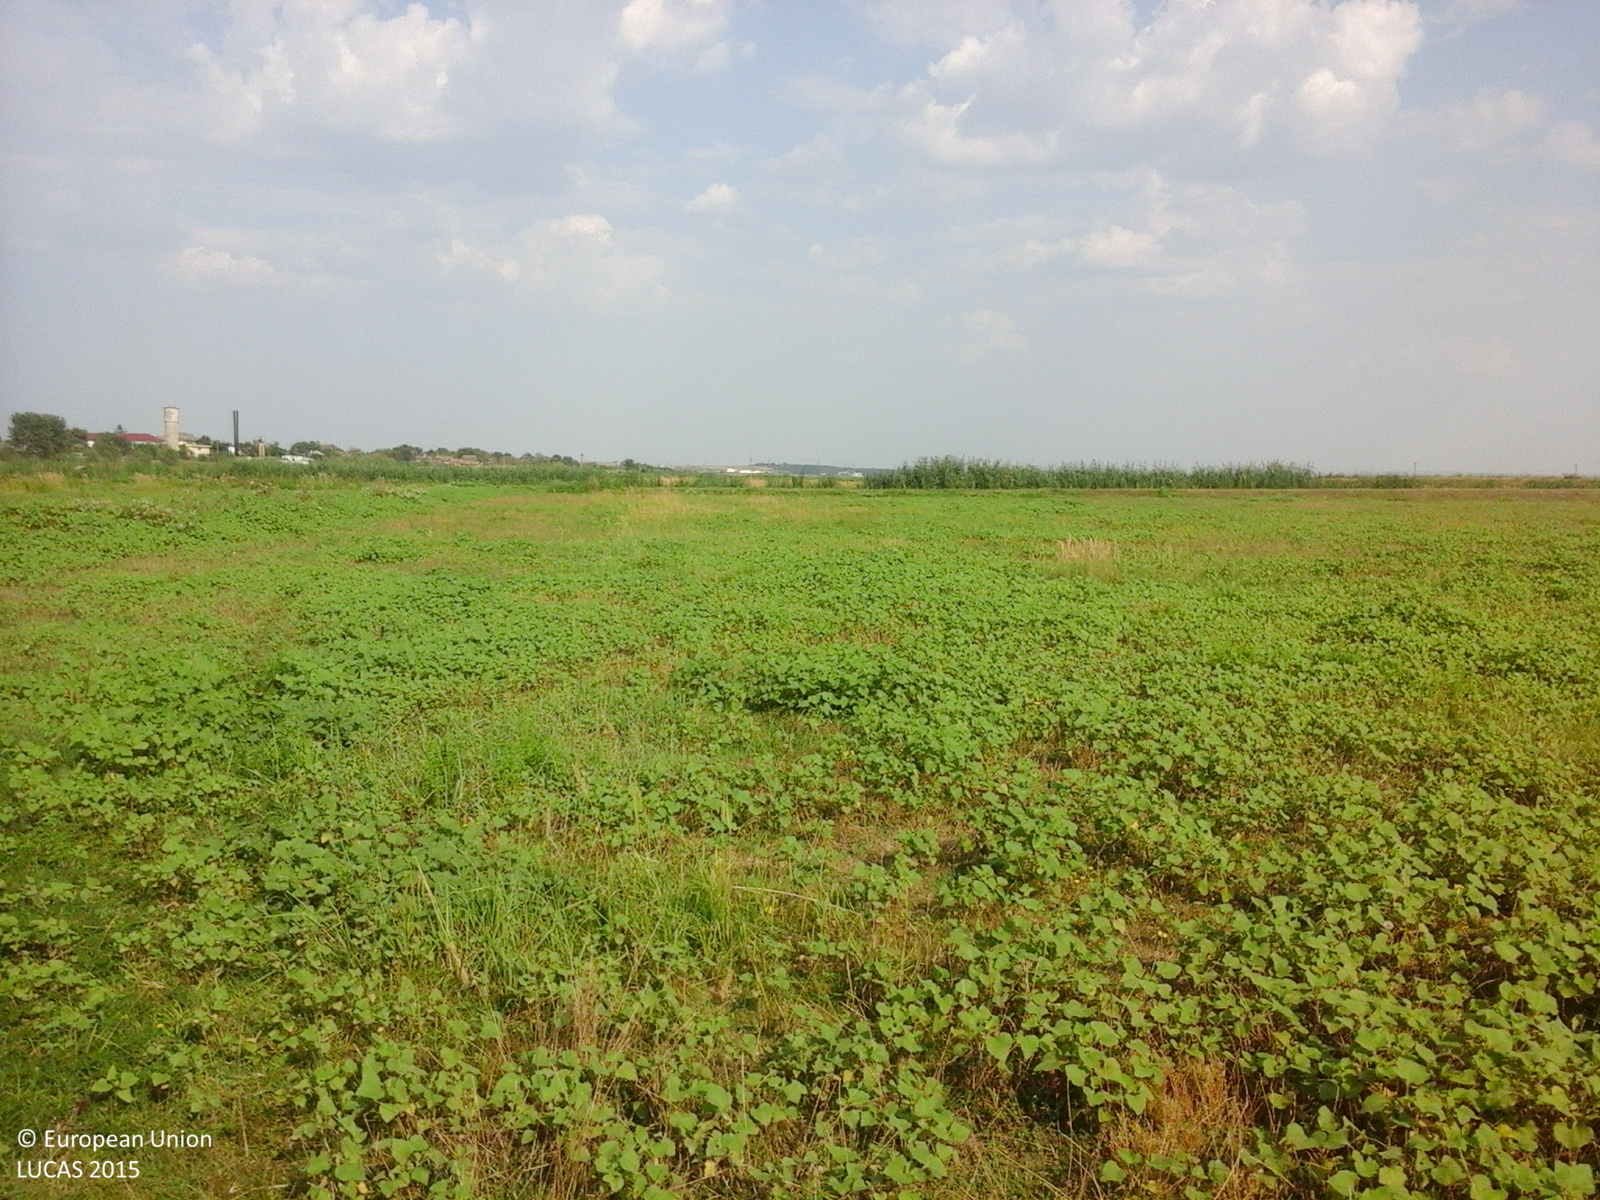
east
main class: Grassland
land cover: Spontaneously vegetated surfaces
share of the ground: > 75 %
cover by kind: herbaceous plants 100 %
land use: Agriculture (excluding fallow land and kitchen gardens)
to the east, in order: Spontaneously vegetated surfaces; Tracks; Inland marshes; Ditches and canals; Inland marshes; Spontaneously vegetated surfaces
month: August
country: RO
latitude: 43.8751
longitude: 23.7032
